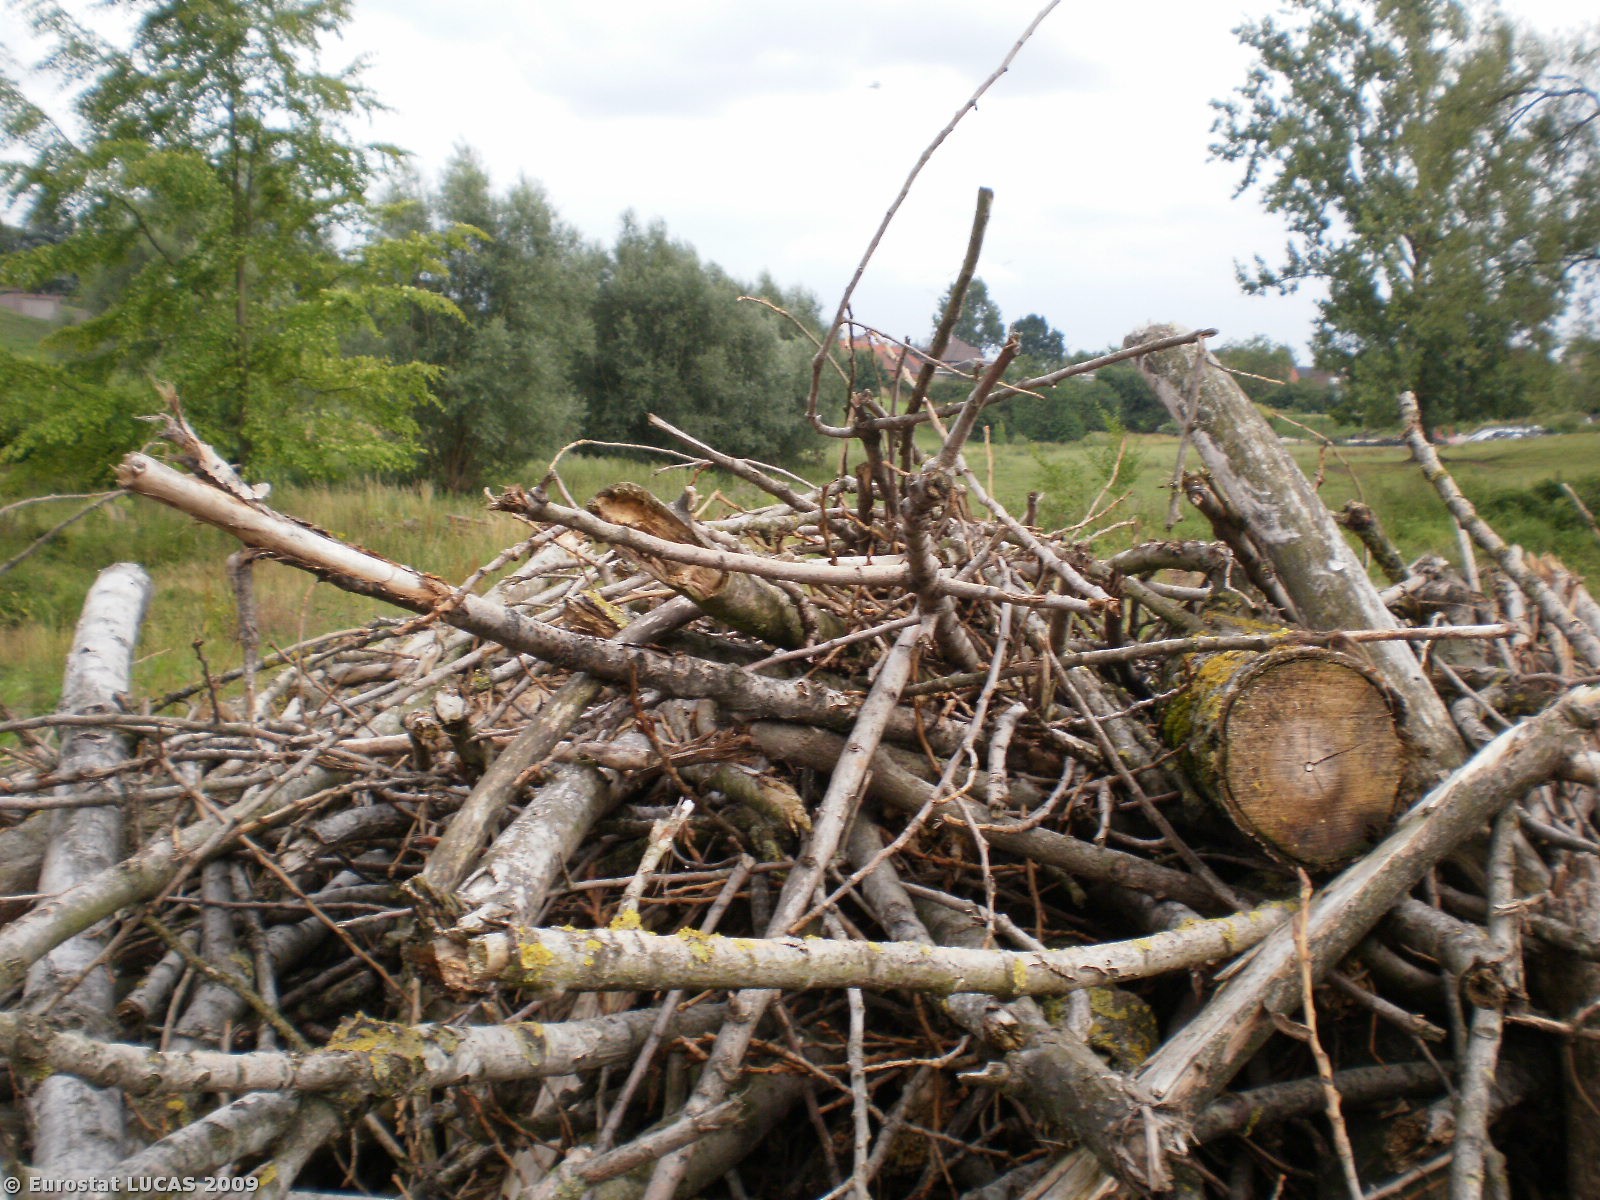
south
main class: Woodland
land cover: Broadleaved woodland
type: acidophilous oak and oak-birch forest
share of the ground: > 75 %
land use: Forestry
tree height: > 5 m
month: July
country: BE
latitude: 50.9009
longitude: 4.1790
